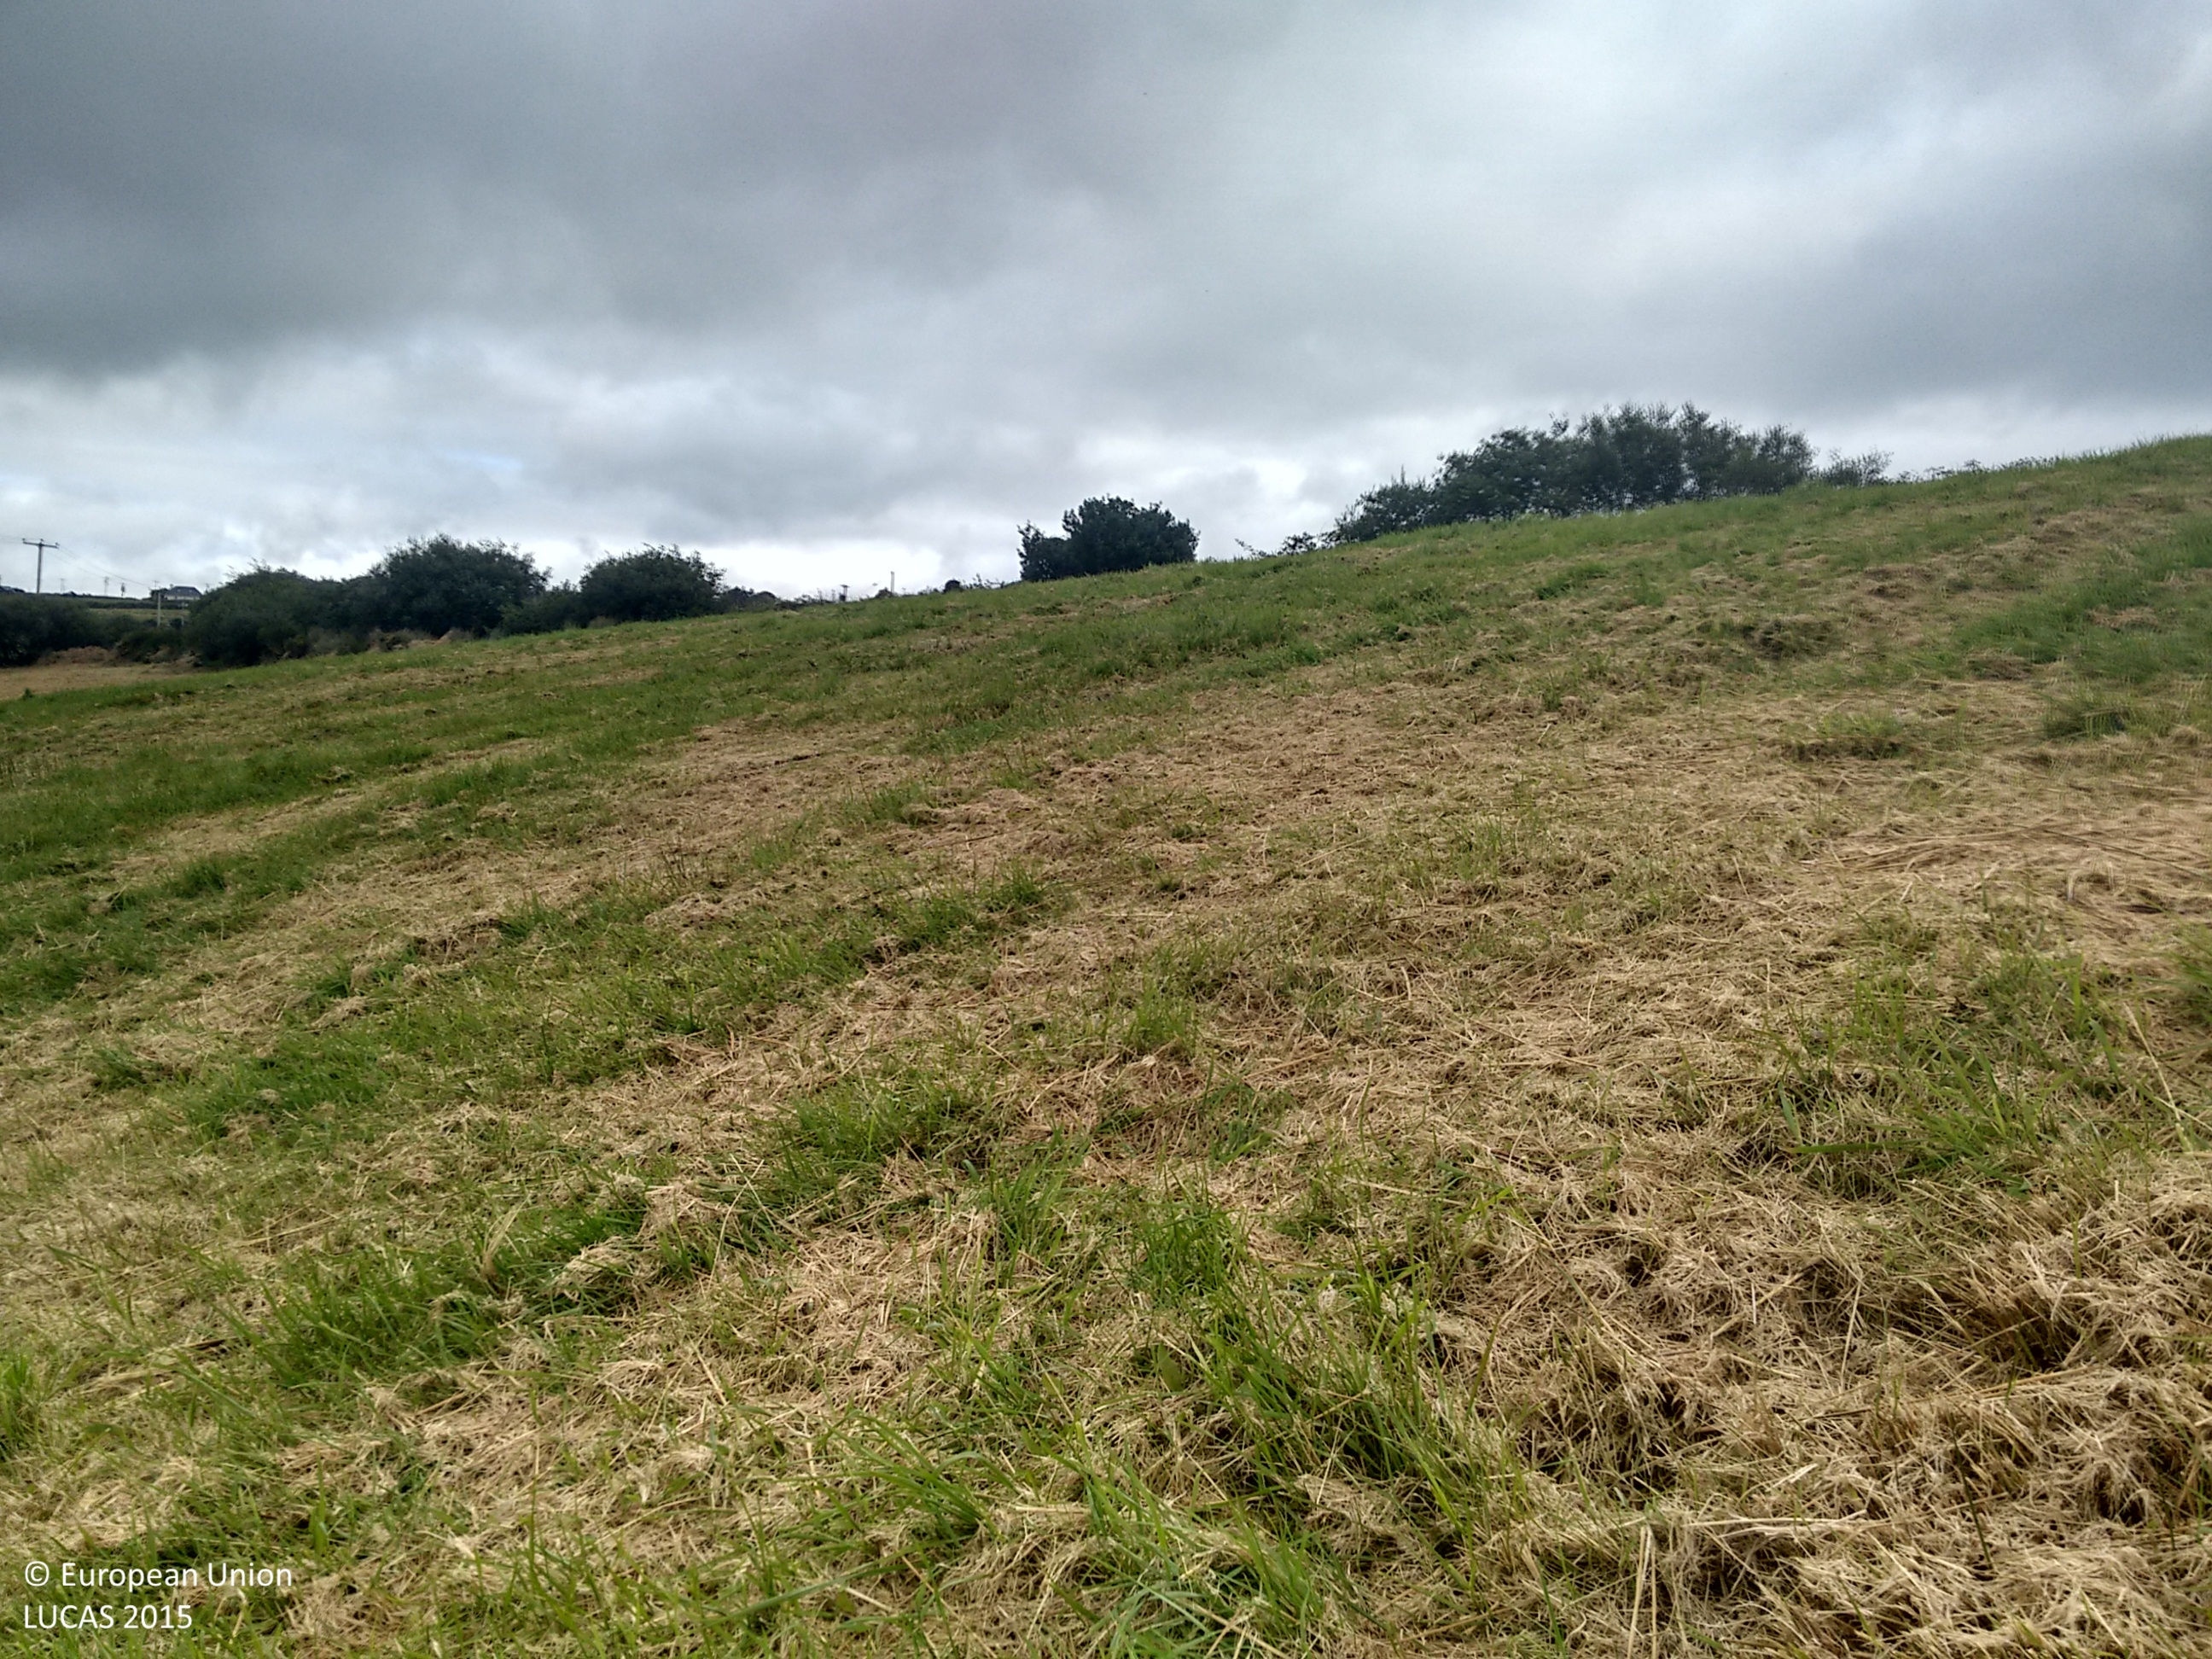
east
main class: Grassland
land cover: Grassland without tree/shrub cover
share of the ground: > 75 %
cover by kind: herbaceous plants 100 %
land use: Agriculture (excluding fallow land and kitchen gardens)
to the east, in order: Grassland without tree/shrub cover; Rivers and streams; Dry stone walls; Fences; Shrubland without tree cover; Grassland without tree/shrub cover; Abandoned hedges; Fences; Grassland without tree/shrub cover; Electric lines; Grassland without tree/shrub cover
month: September
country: IE
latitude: 52.1449
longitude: -10.1491
